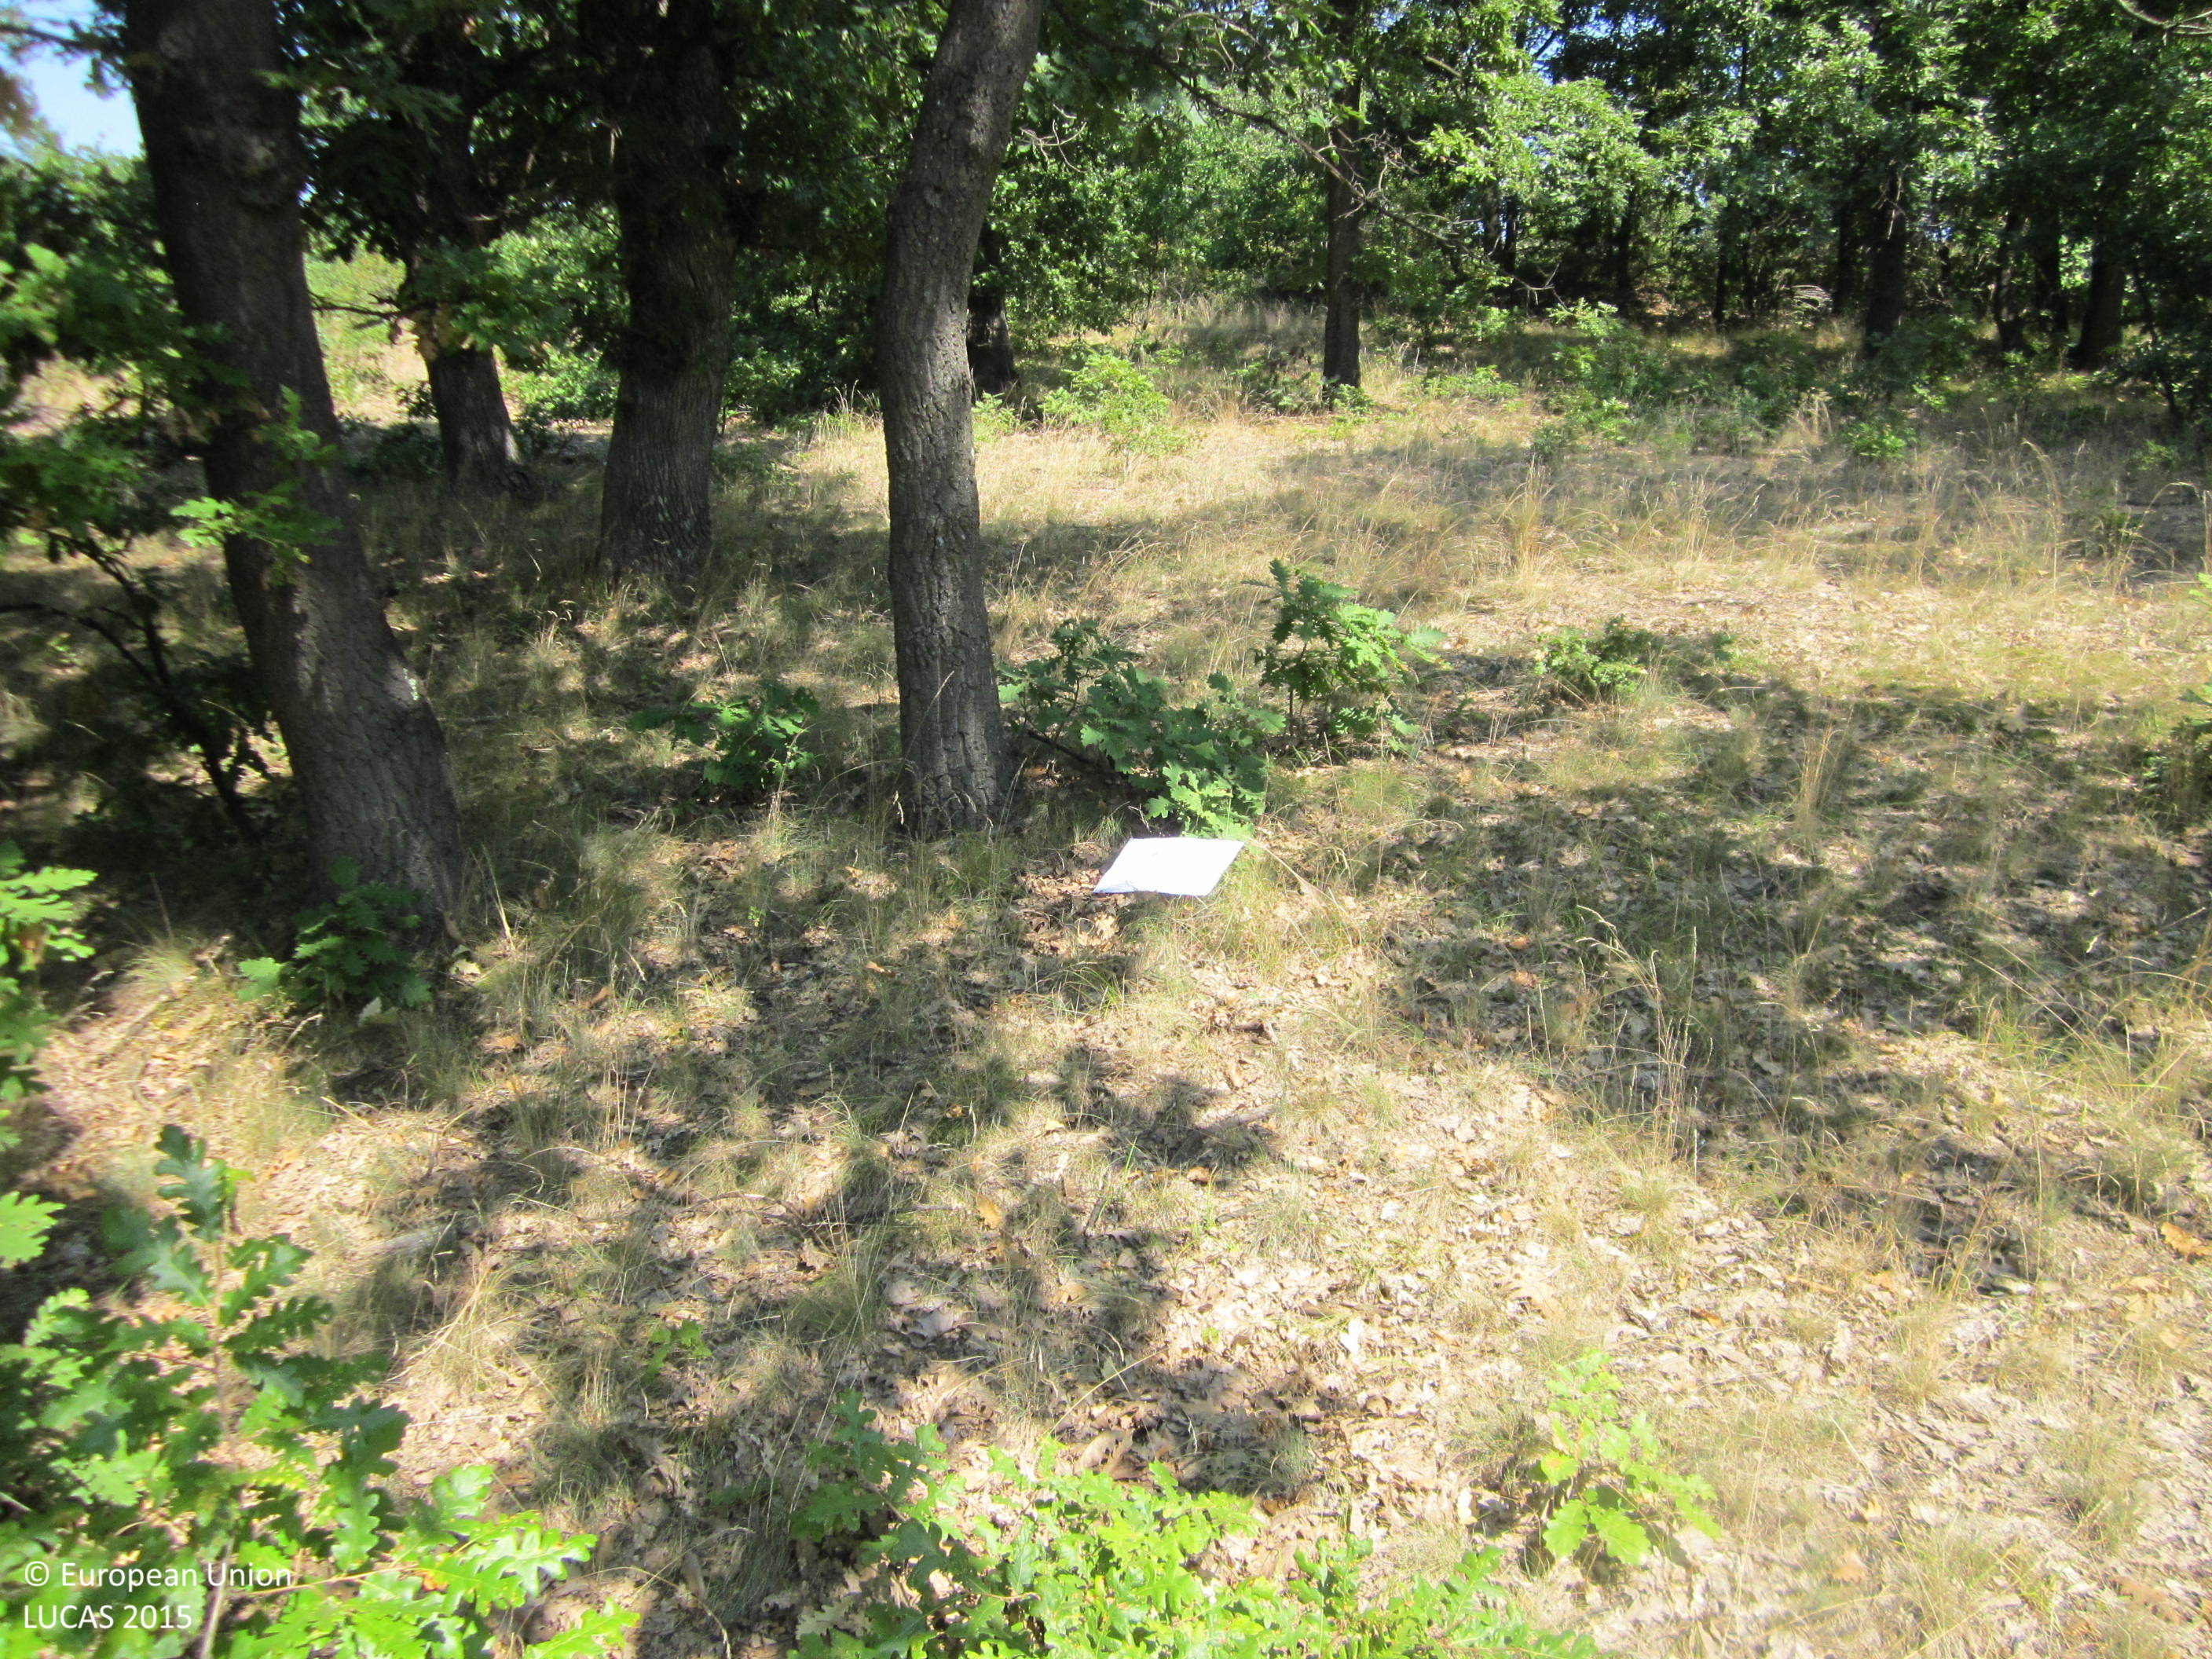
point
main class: Woodland
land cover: Broadleaved woodland
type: thermophilous deciduous forest
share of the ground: > 75 %
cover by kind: broadleaved forest trees 75 %, herbaceous plants 20 %, unconsolidated bare surface 5 %
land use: Forestry
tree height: > 5 m
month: September
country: BG
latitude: 42.8556
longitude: 27.0355
